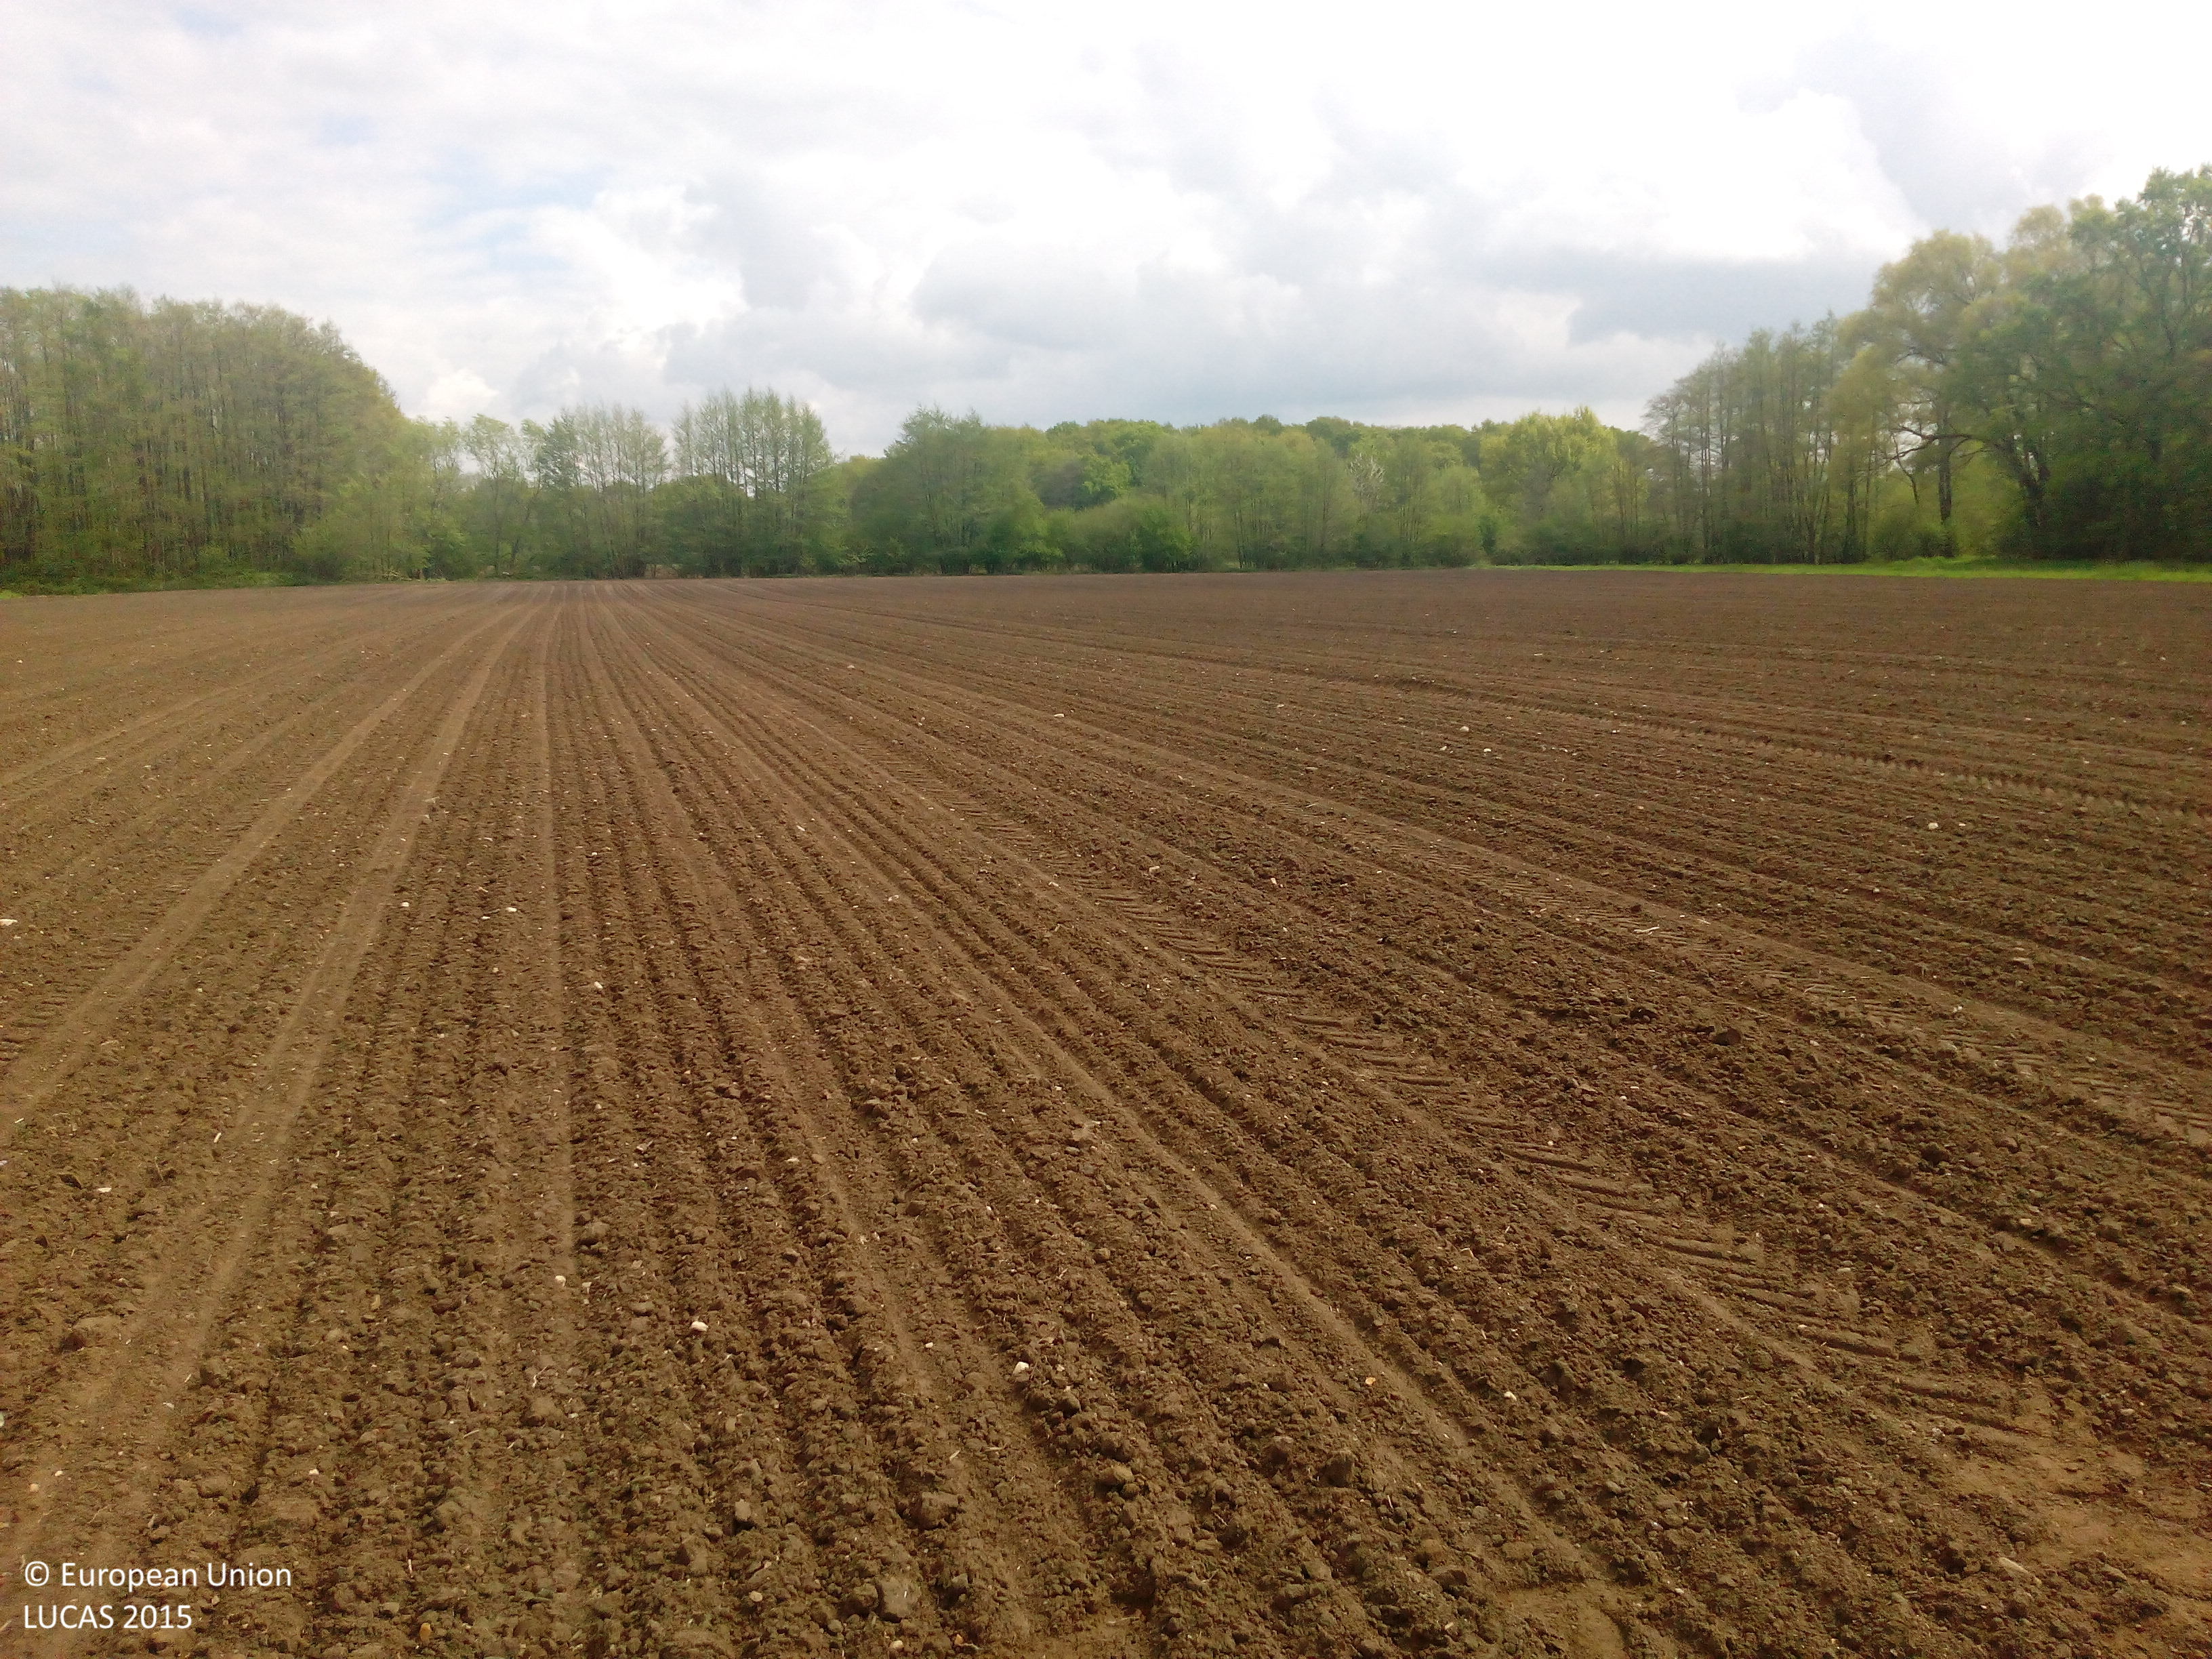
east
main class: Cropland
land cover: Maize
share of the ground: < 10 %
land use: Agriculture (excluding fallow land and kitchen gardens)
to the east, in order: Maize; Broadleaved woodland; Ditches and canals; Broadleaved woodland; Maize
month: May
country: DE
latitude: 51.9007
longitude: 7.4569
